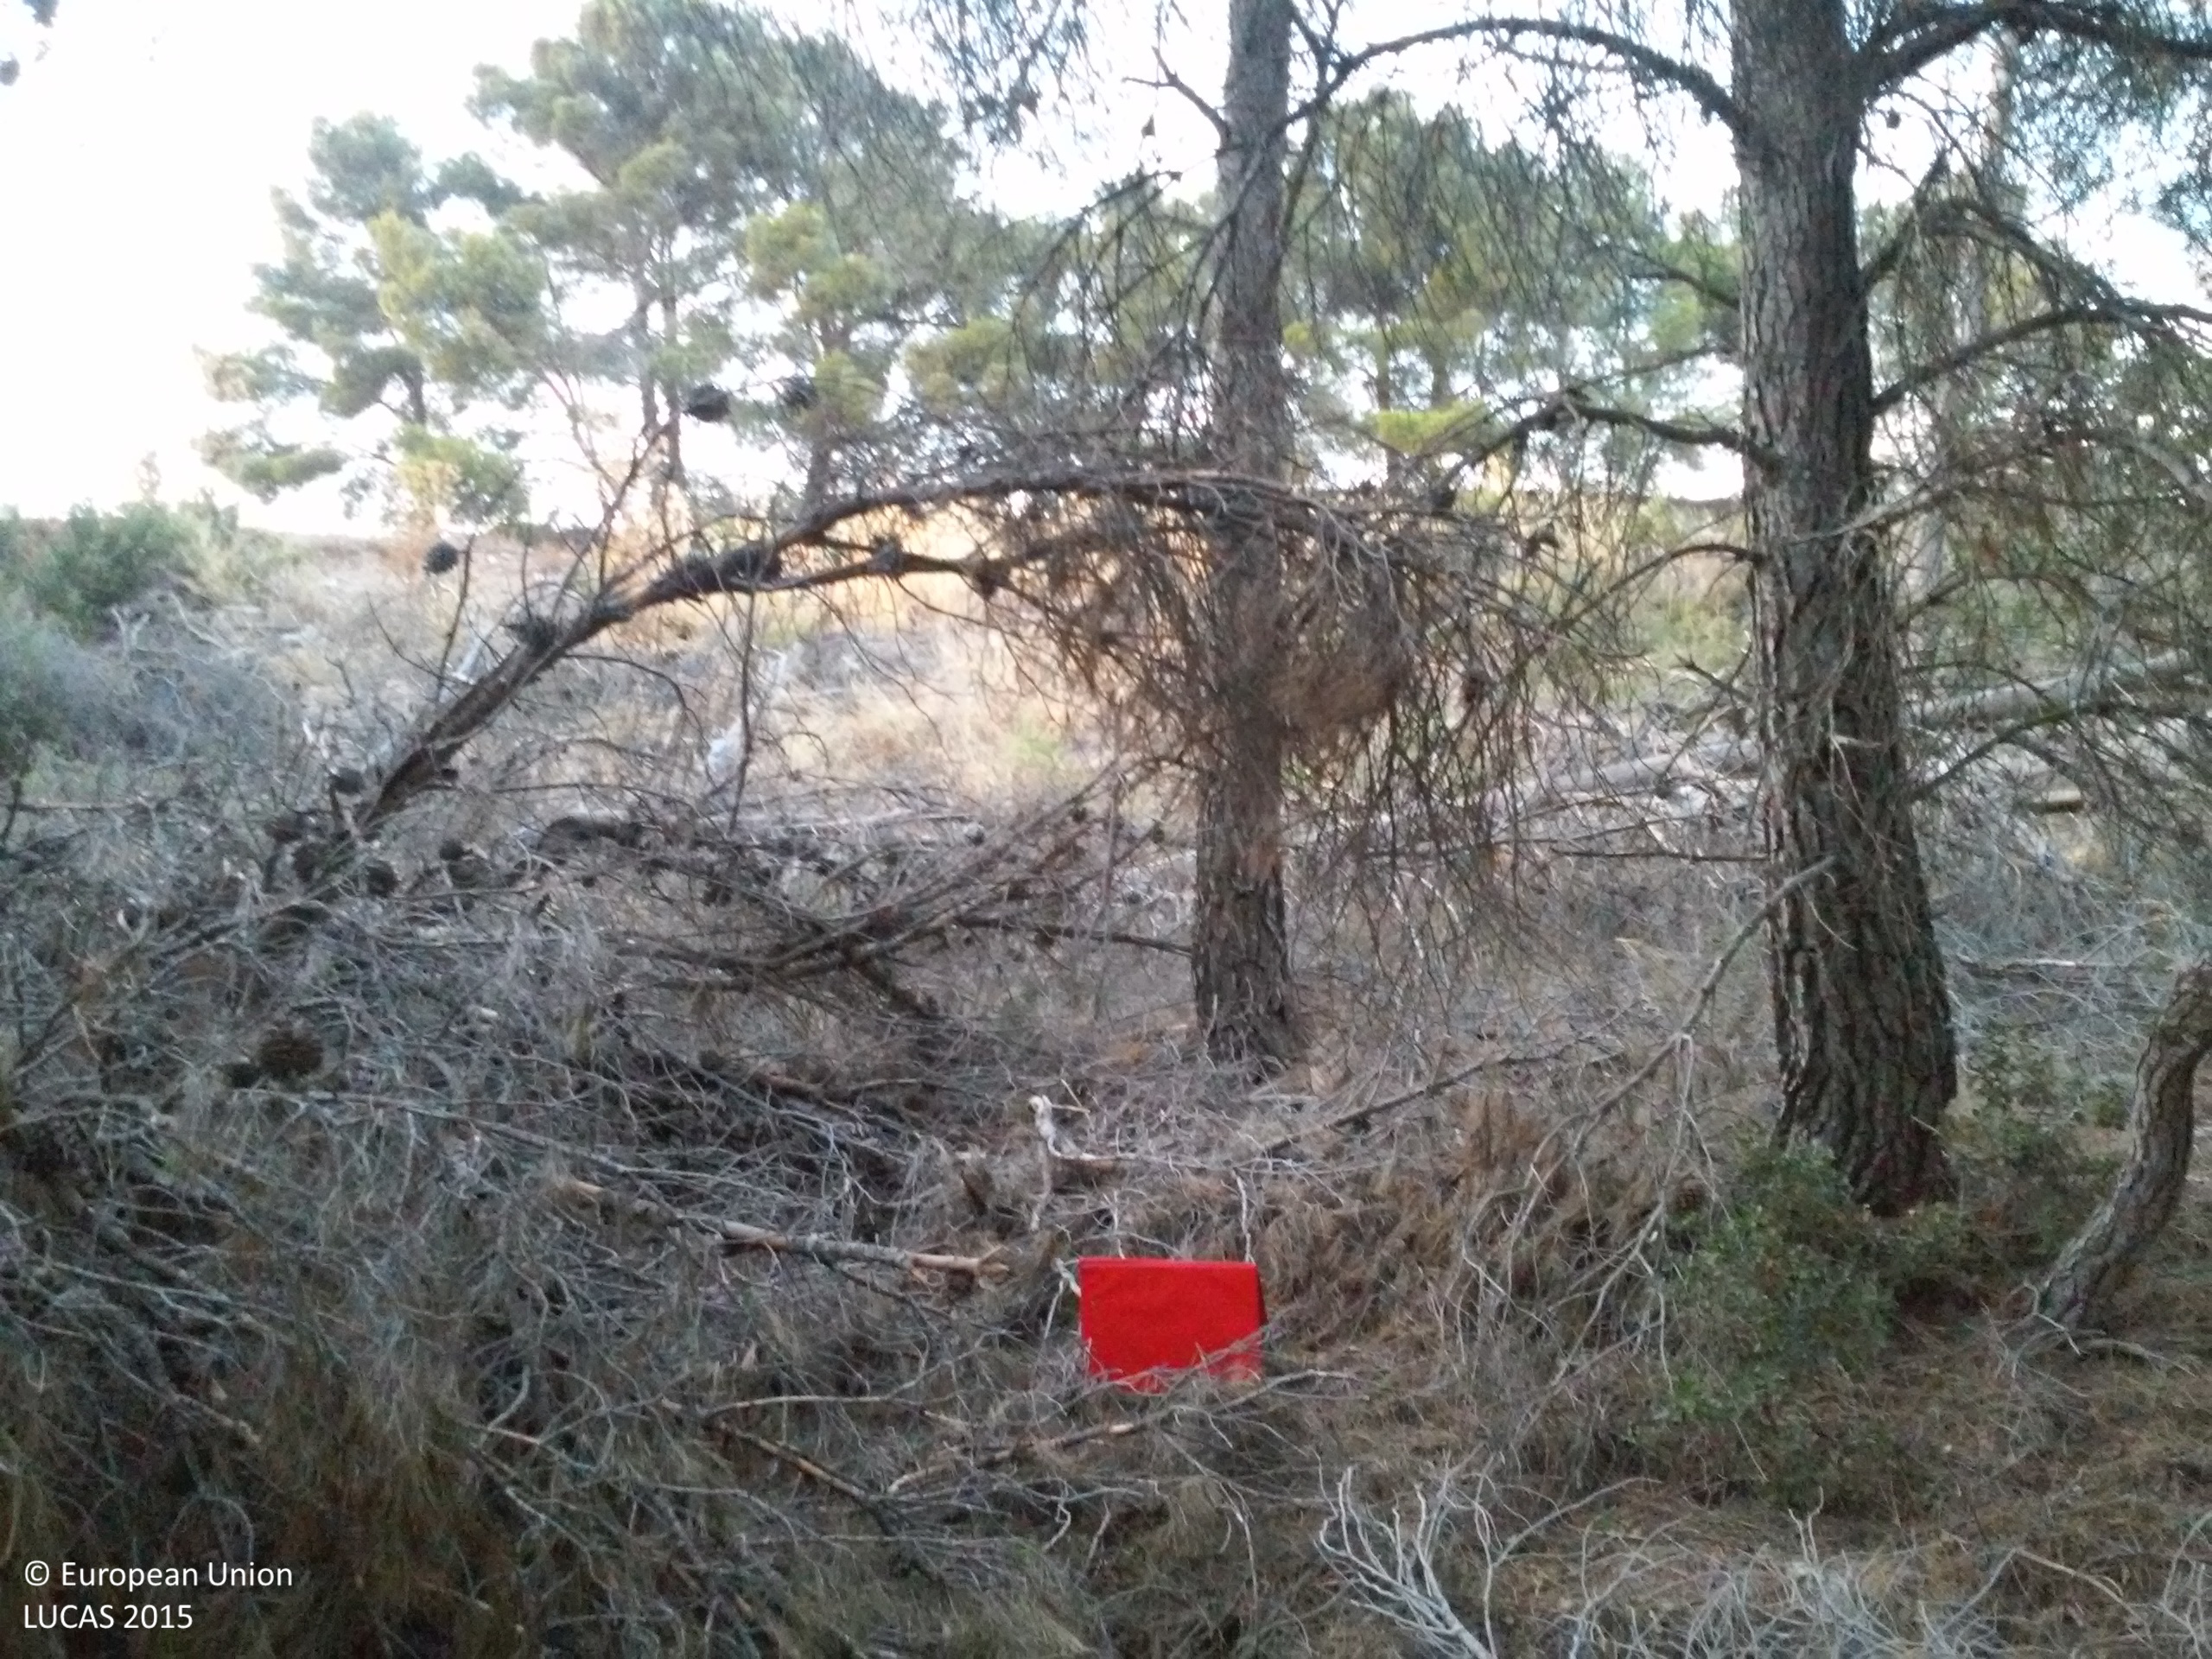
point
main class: Woodland
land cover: Pine dominated coniferous woodland
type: coniferous forest of the mediterranean region
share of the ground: 25 - 50 %
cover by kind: coniferous forest trees 60 %, shrubs 15 %, herbaceous plants 15 %, lichens and mosses 10 %
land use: Semi-natural and natural areas not in use
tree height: > 5 m
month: July
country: ES
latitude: 41.5980
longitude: 1.1959
